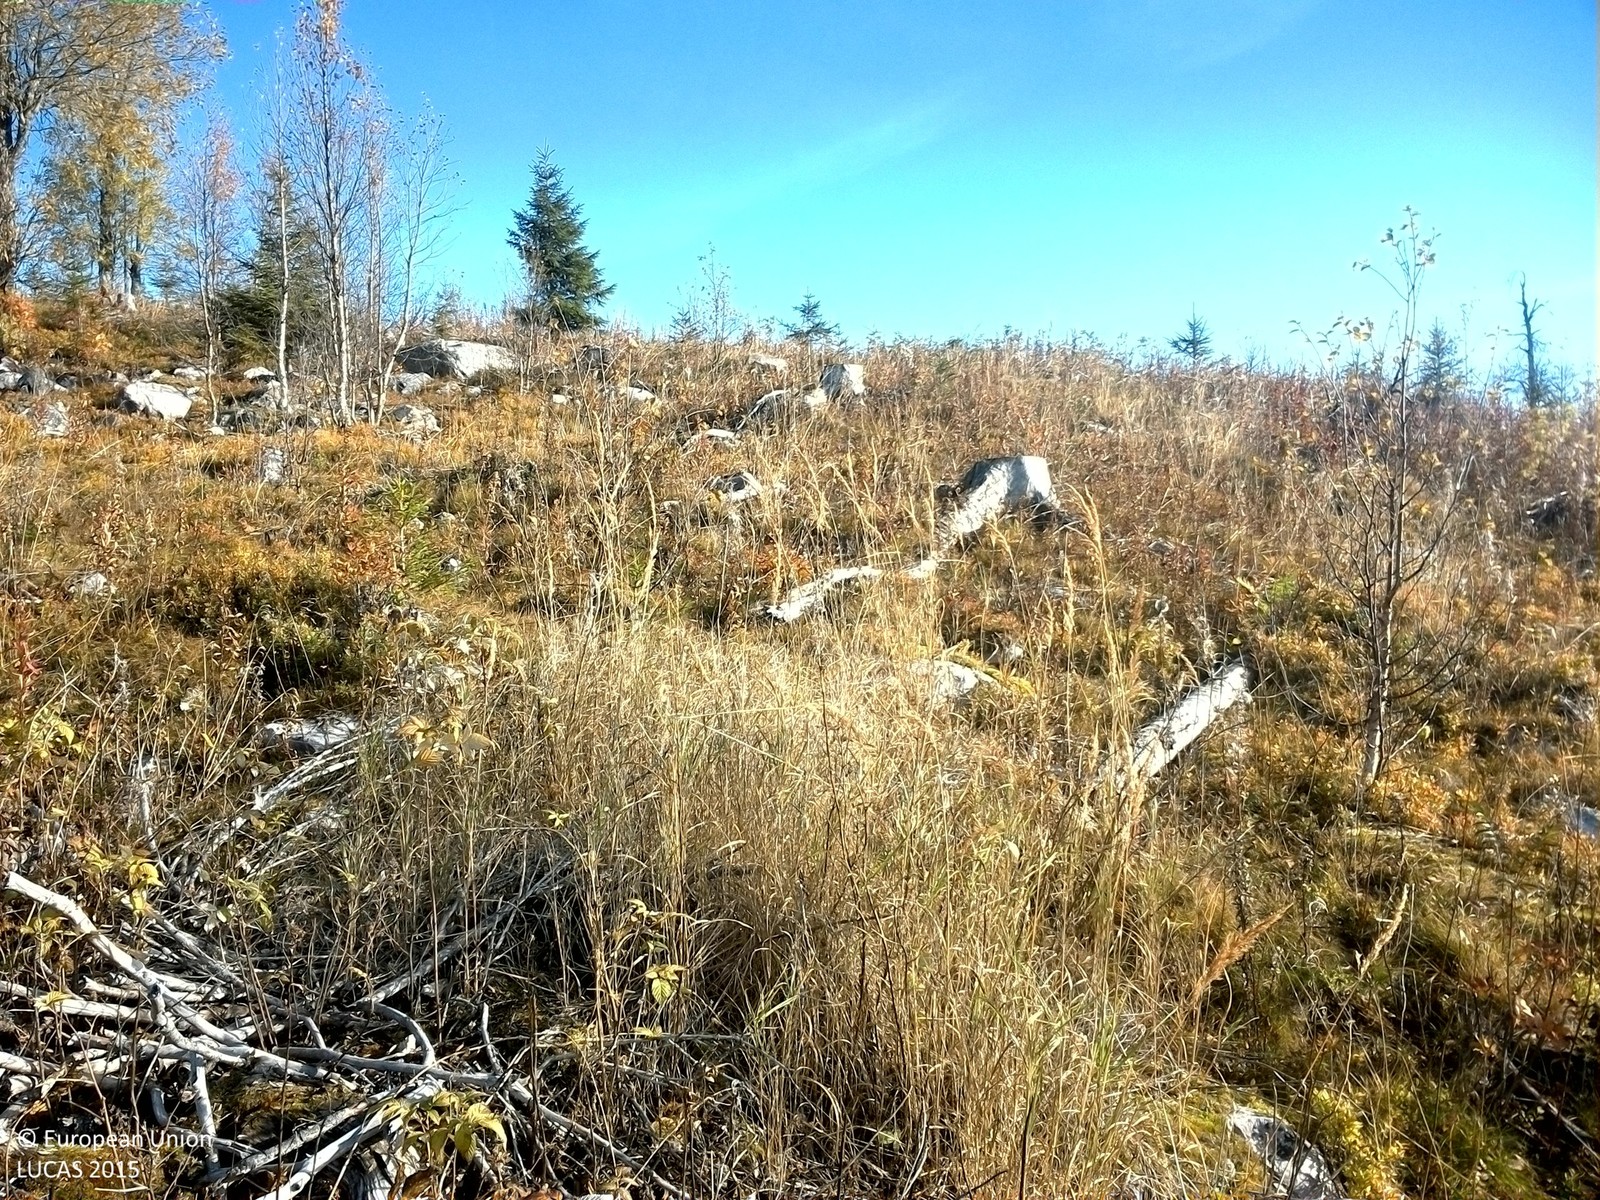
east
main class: Woodland
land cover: Spruce dominated mixed woodland
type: boreal forest
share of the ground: 10 - 25 %
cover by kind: herbaceous plants 45 %, shrubs 20 %, lichens and mosses 20 %, coniferous forest trees 10 %, broadleaved forest trees 5 %
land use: Forestry
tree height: < 5 m
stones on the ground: > 50 %
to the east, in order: Spruce dominated mixed woodland
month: October
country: SE
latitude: 64.5218
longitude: 15.4498
